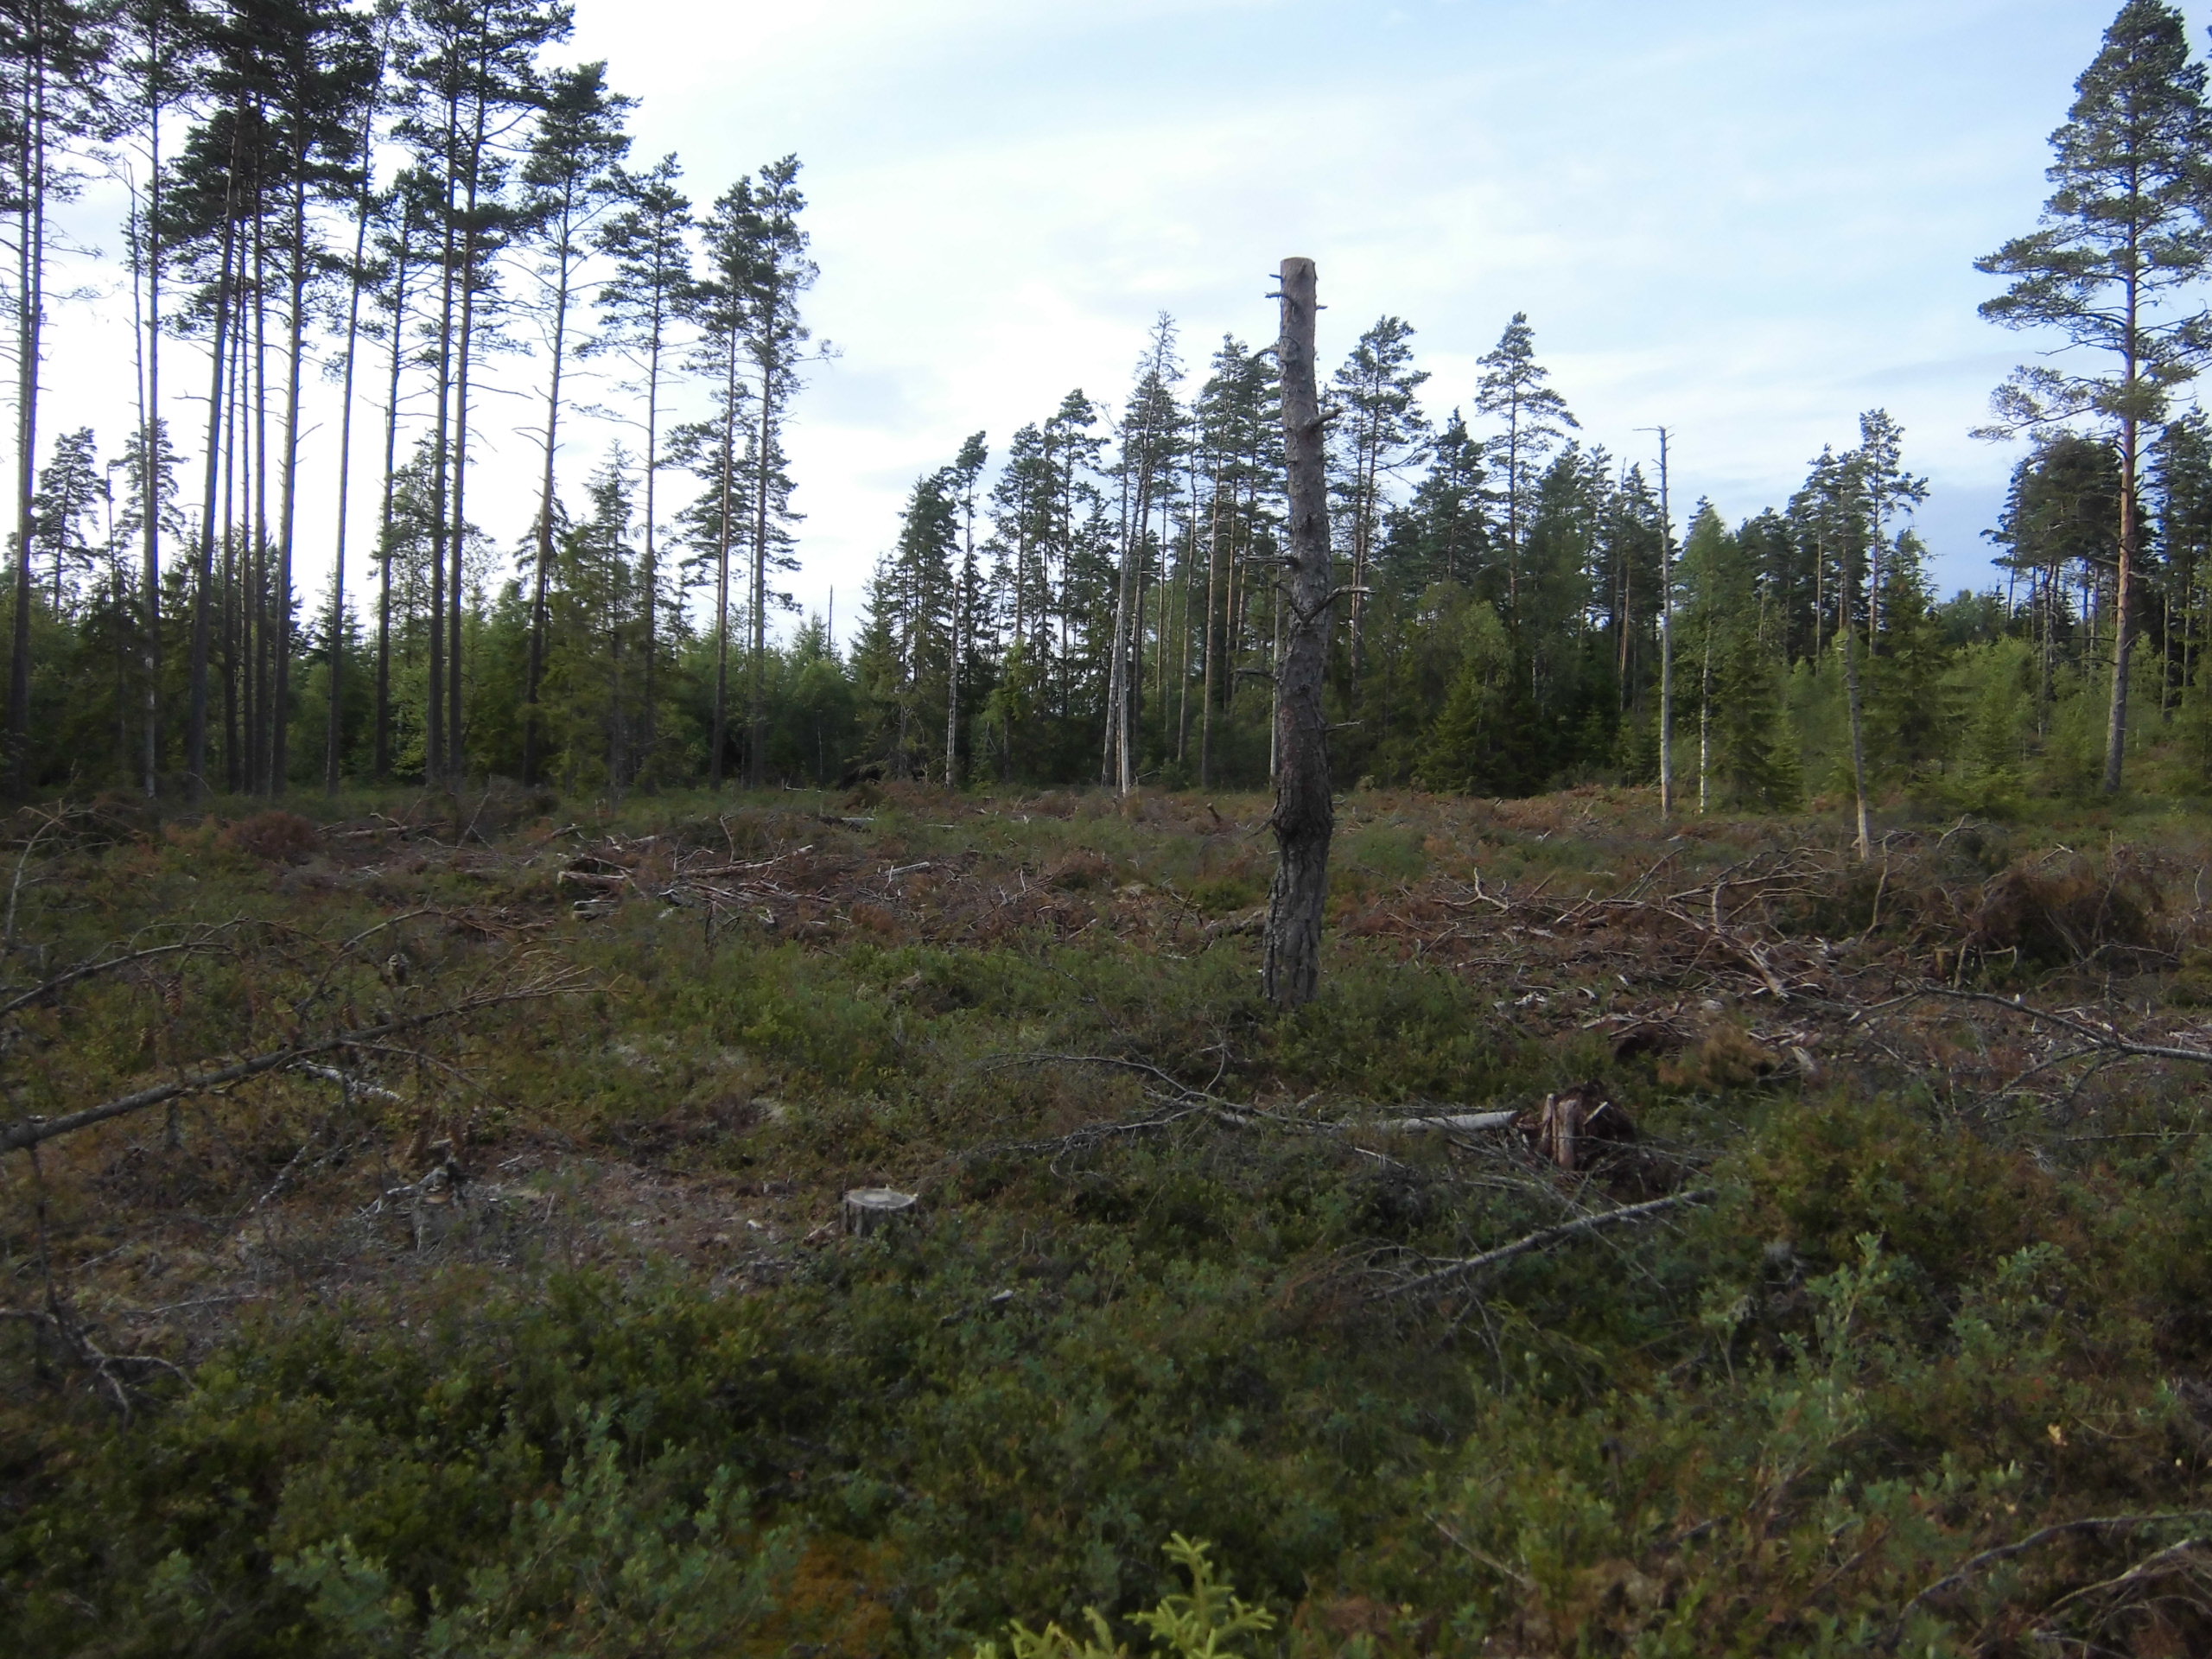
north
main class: Shrubland
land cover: Shrubland with sparse tree cover
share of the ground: 25 - 50 %
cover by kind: shrubs 35 %, unconsolidated bare surface 30 %, lichens and mosses 20 %, herbaceous plants 10 %, coniferous forest trees 5 %
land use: Forestry
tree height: > 5 m
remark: Clear cut
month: July
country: SE
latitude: 57.4858
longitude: 14.7833
